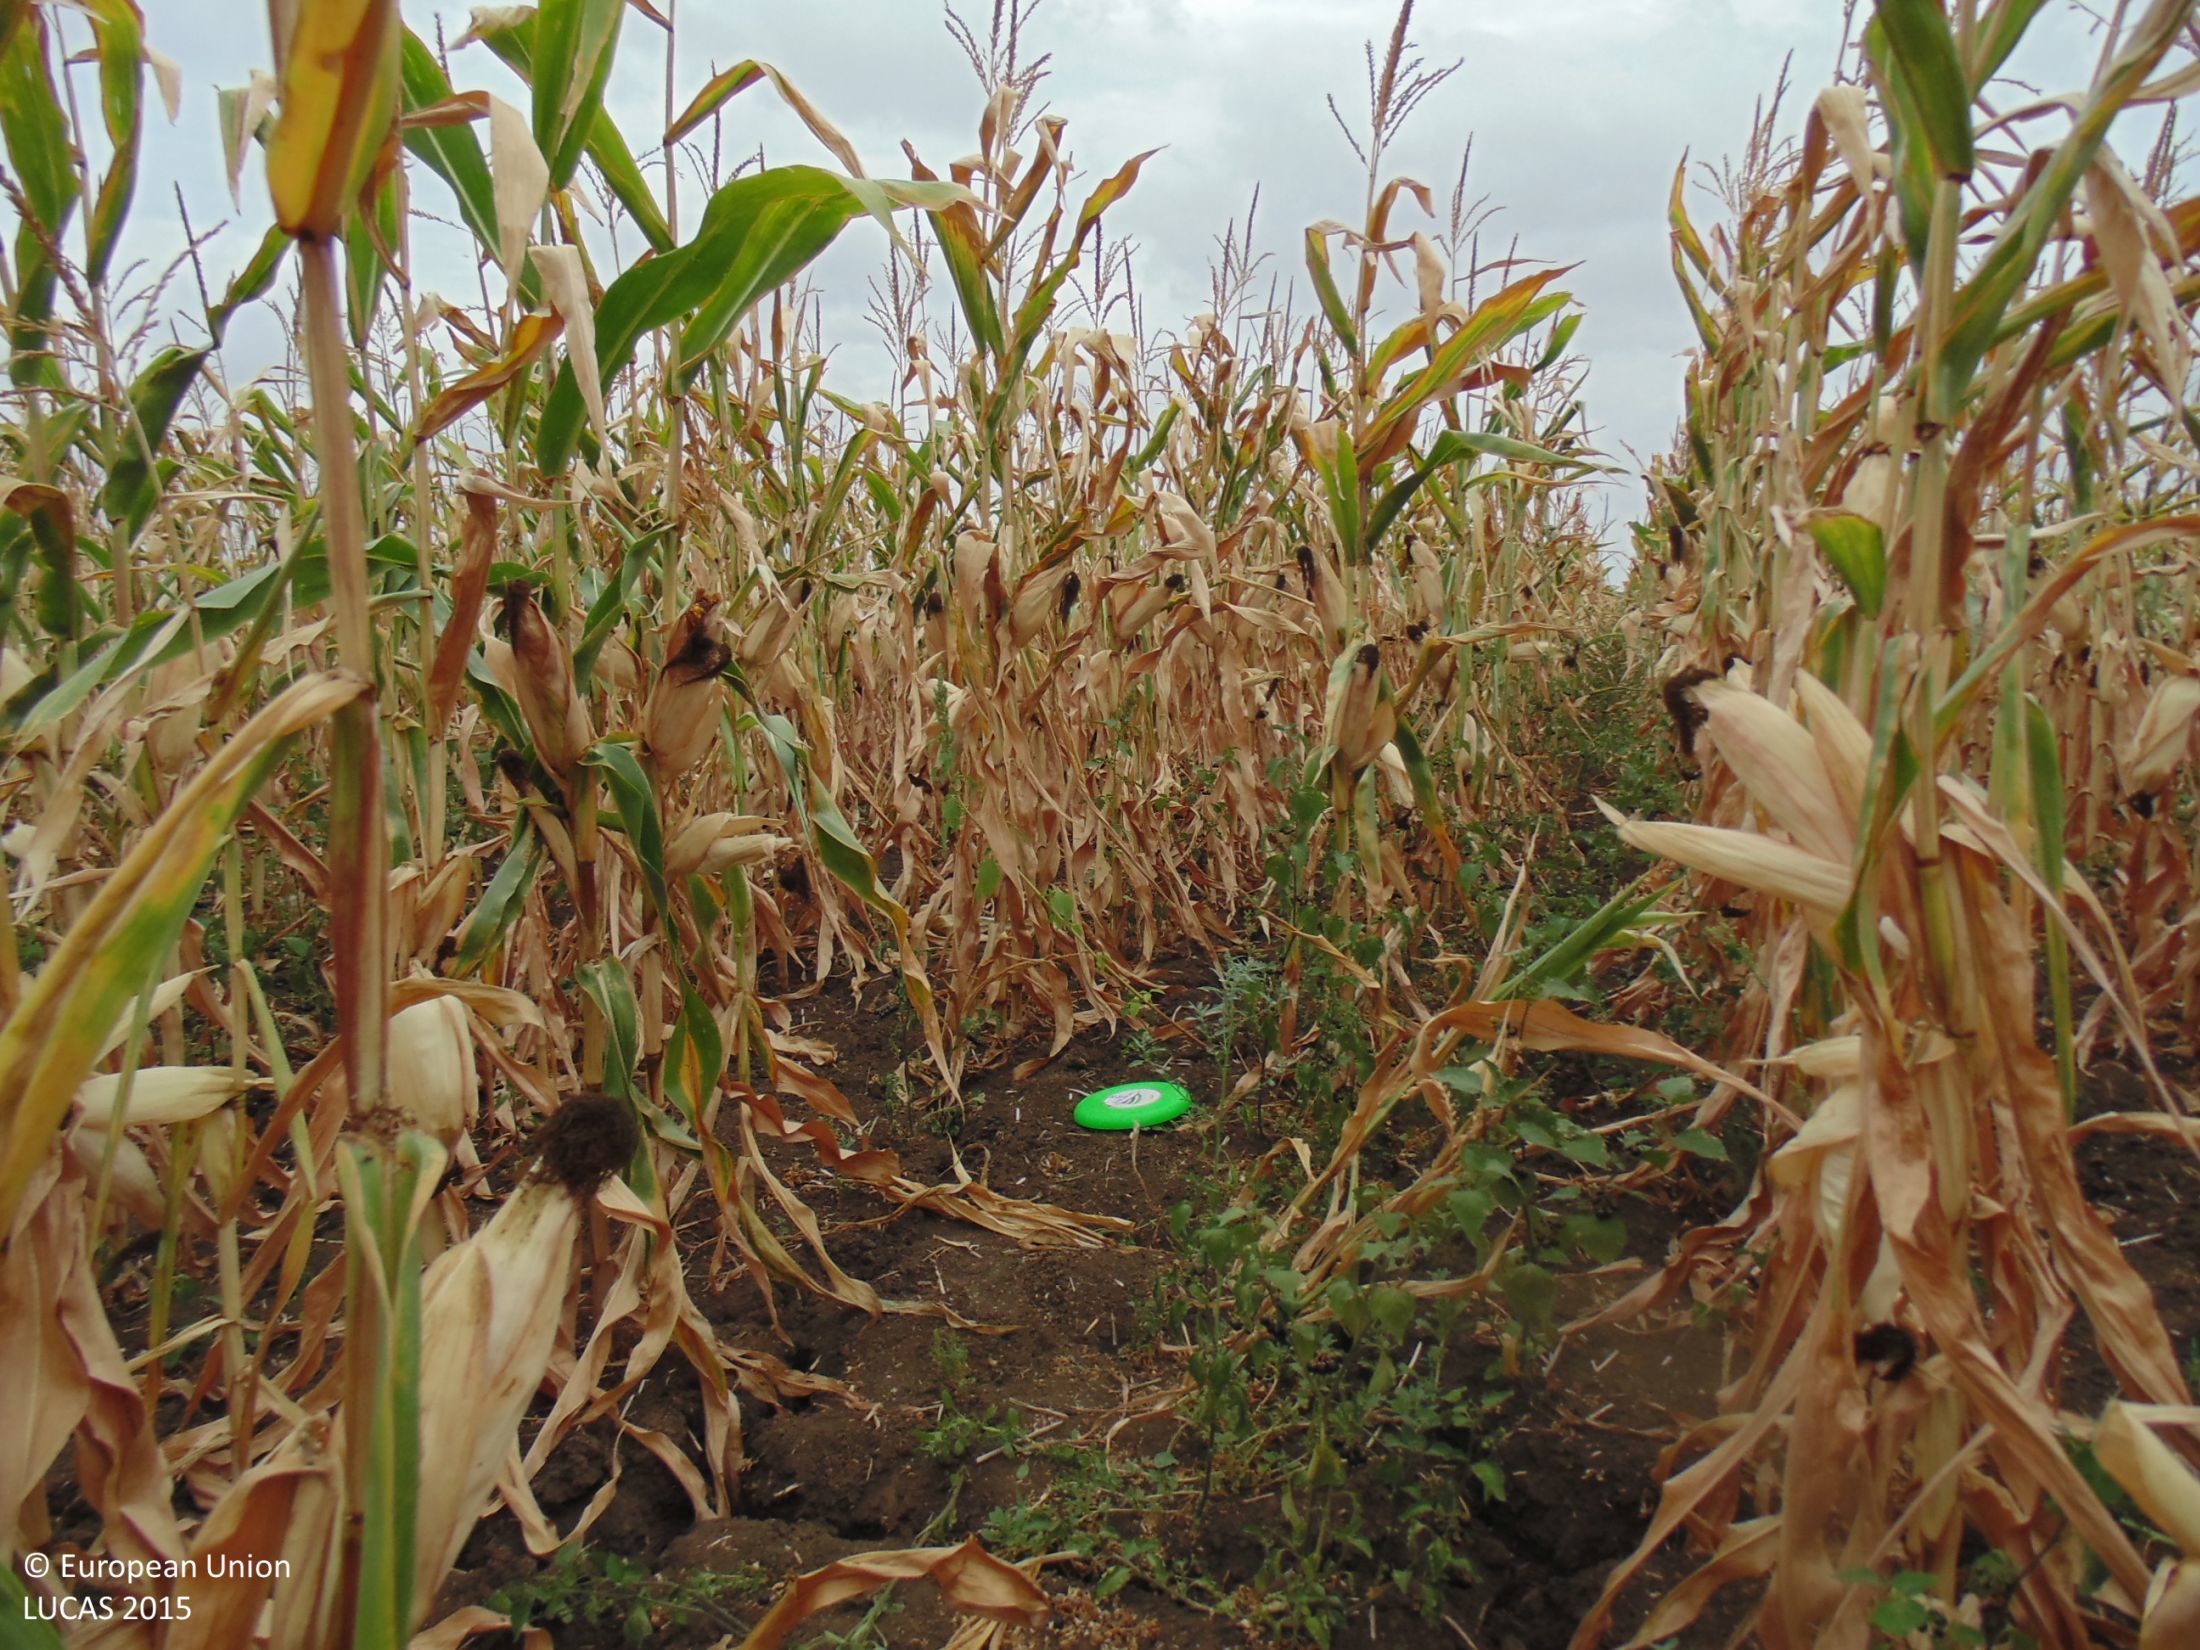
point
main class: Cropland
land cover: Maize
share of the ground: > 75 %
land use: Agriculture (excluding fallow land and kitchen gardens)
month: August
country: BG
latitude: 43.5261
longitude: 28.4595
